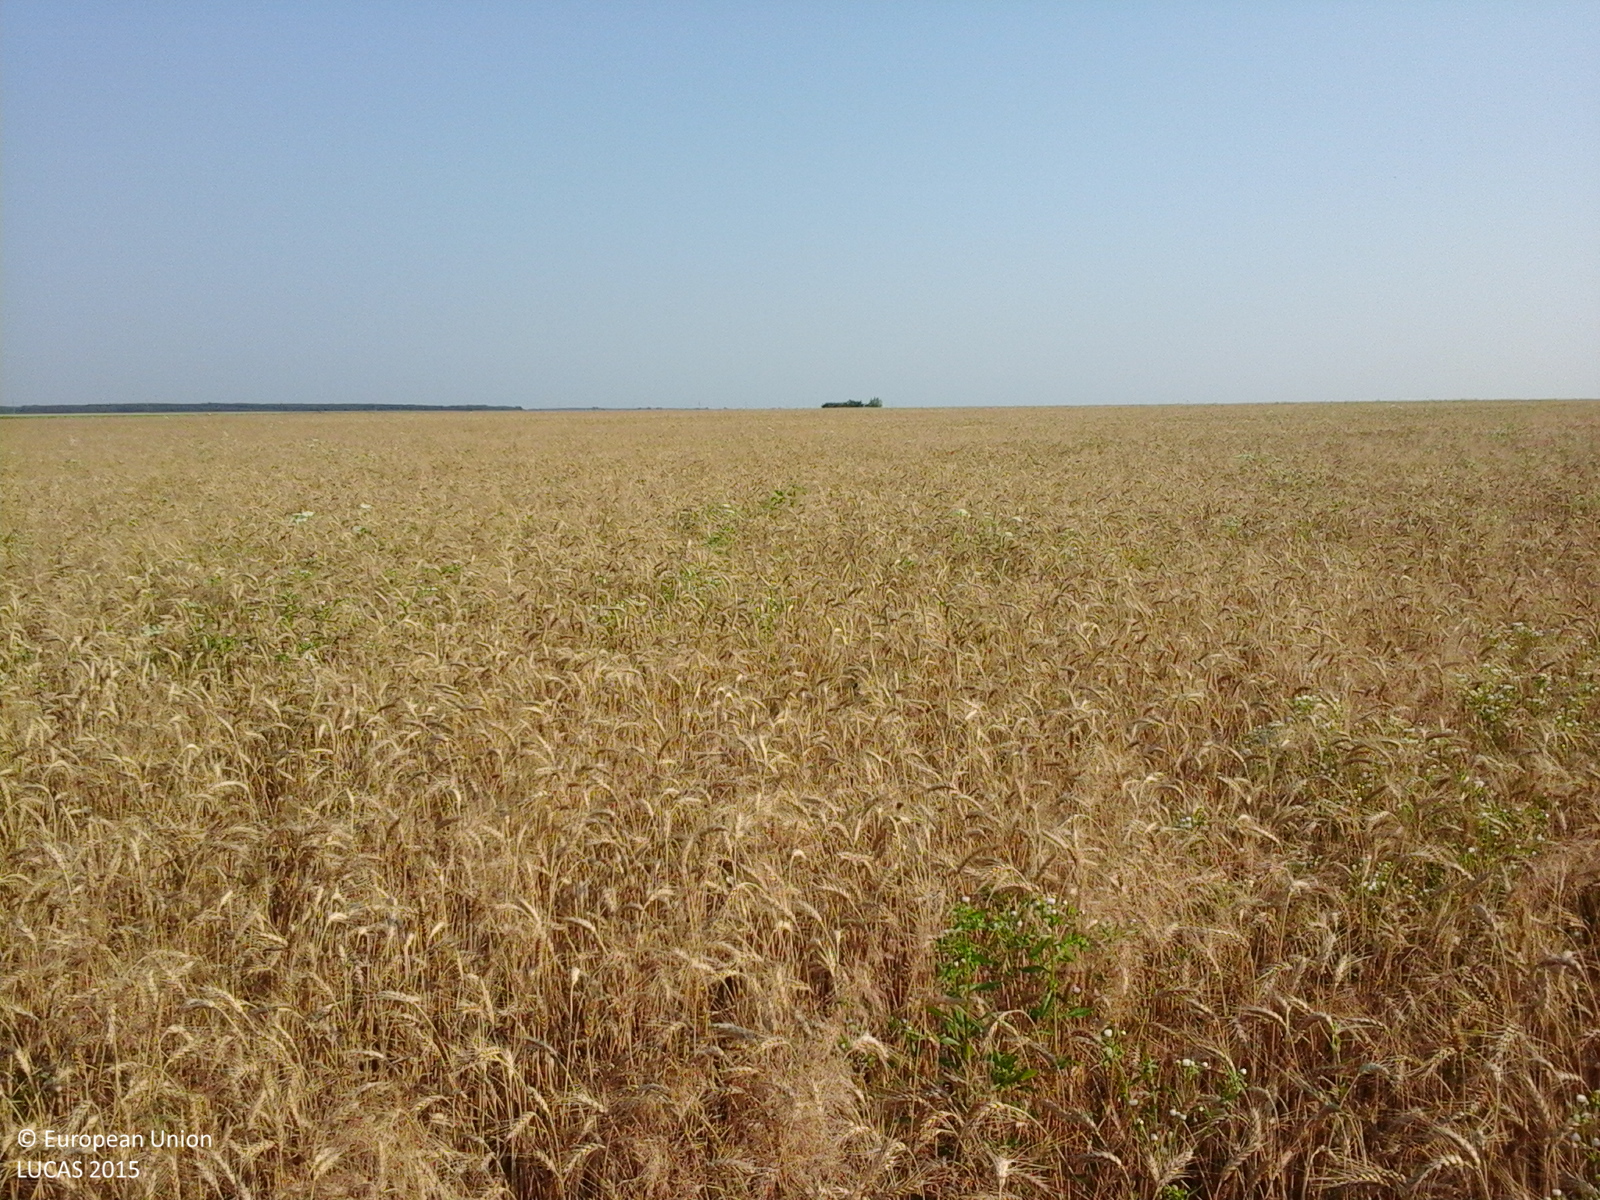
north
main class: Cropland
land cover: Common wheat
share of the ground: > 75 %
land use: Agriculture (excluding fallow land and kitchen gardens)
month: July
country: RO
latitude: 44.6212
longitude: 24.6570
